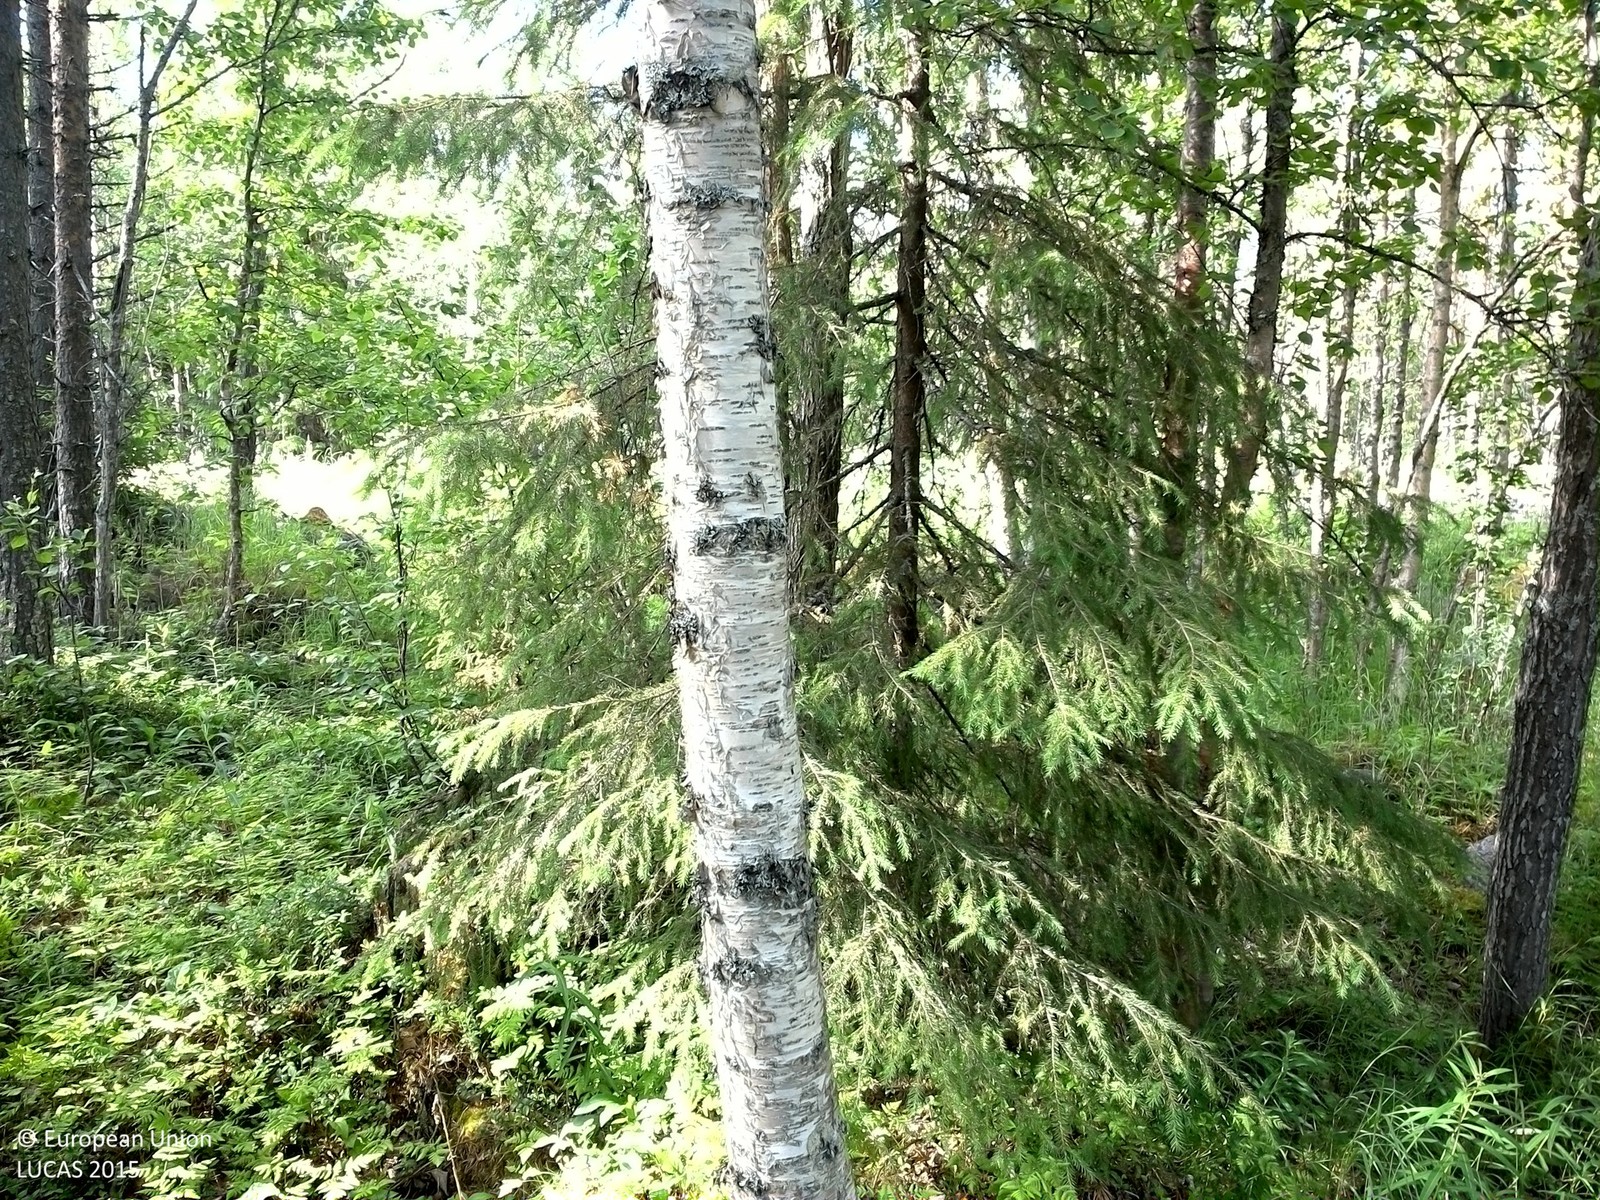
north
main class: Woodland
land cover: Pine dominated mixed woodland
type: boreal forest
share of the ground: 50 - 75 %
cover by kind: coniferous forest trees 35 %, broadleaved forest trees 25 %, herbaceous plants 25 %, shrubs 10 %, lichens and mosses 5 %
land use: Forestry
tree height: > 5 m
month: July
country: SE
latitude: 64.5909
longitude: 15.5465
